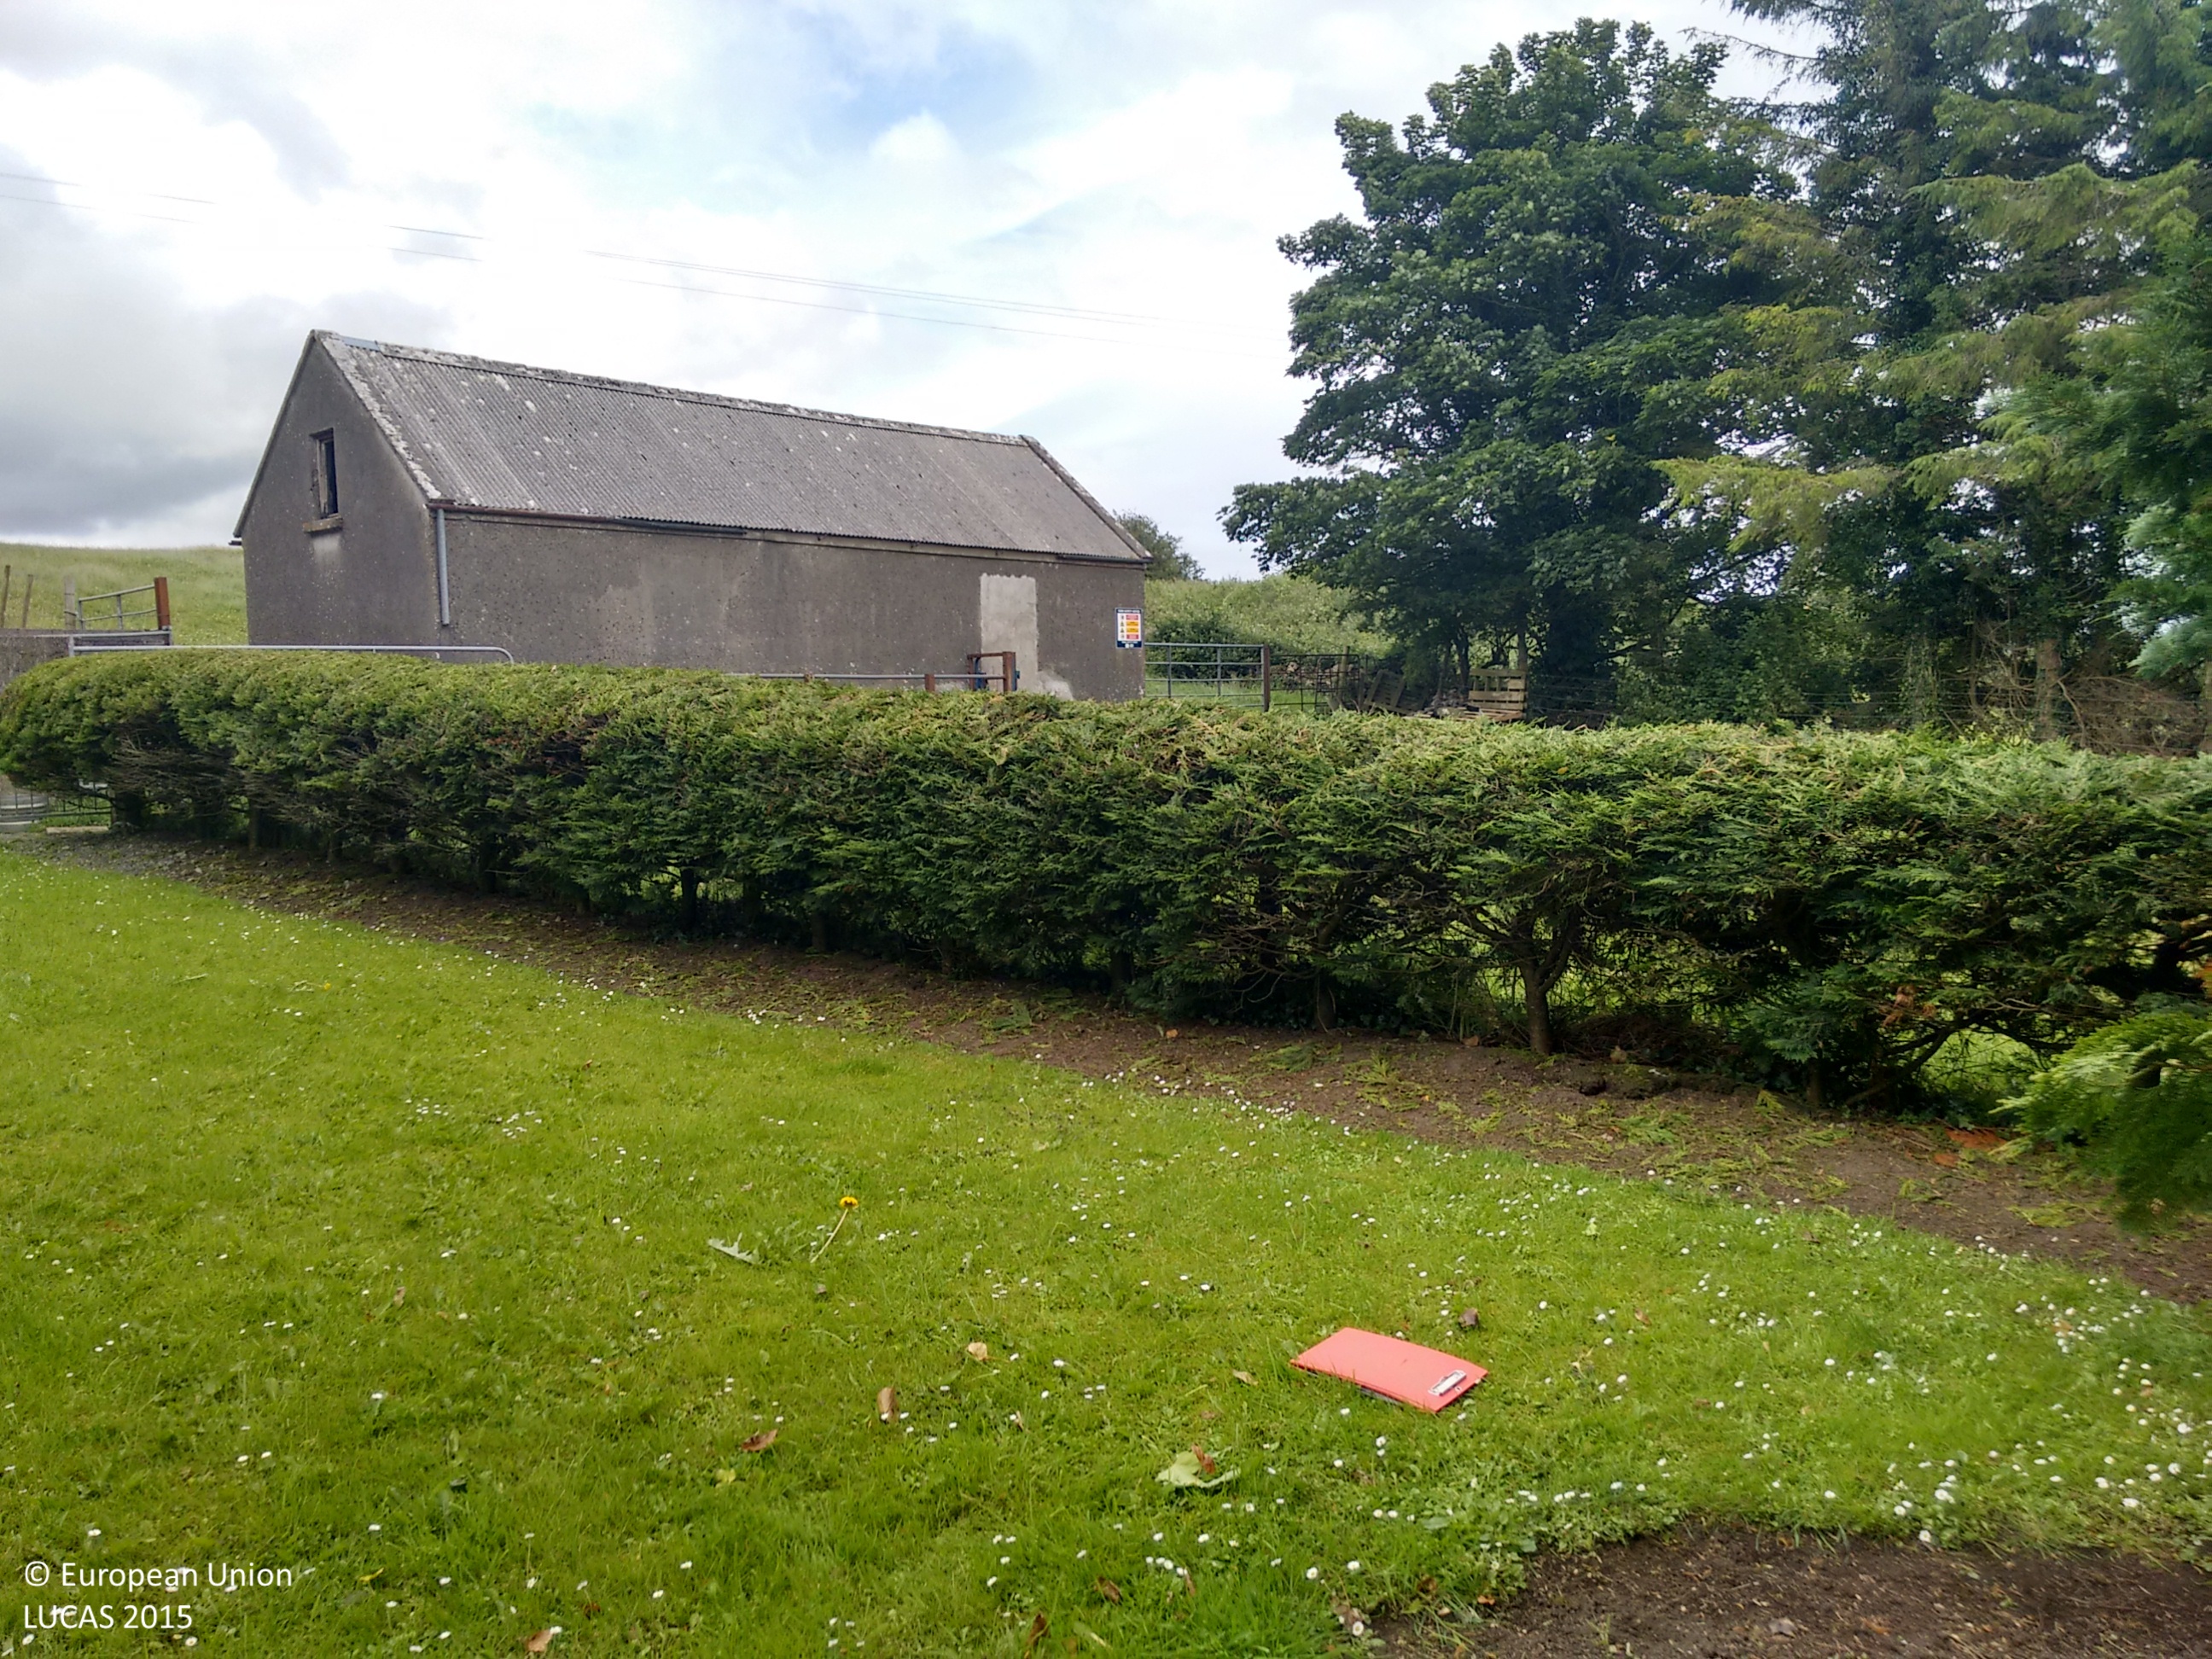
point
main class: Grassland
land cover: Grassland without tree/shrub cover
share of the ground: > 75 %
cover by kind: herbaceous plants 100 %
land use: Agriculture (excluding fallow land and kitchen gardens)
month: July
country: IE
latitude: 53.6567
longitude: -8.8638
